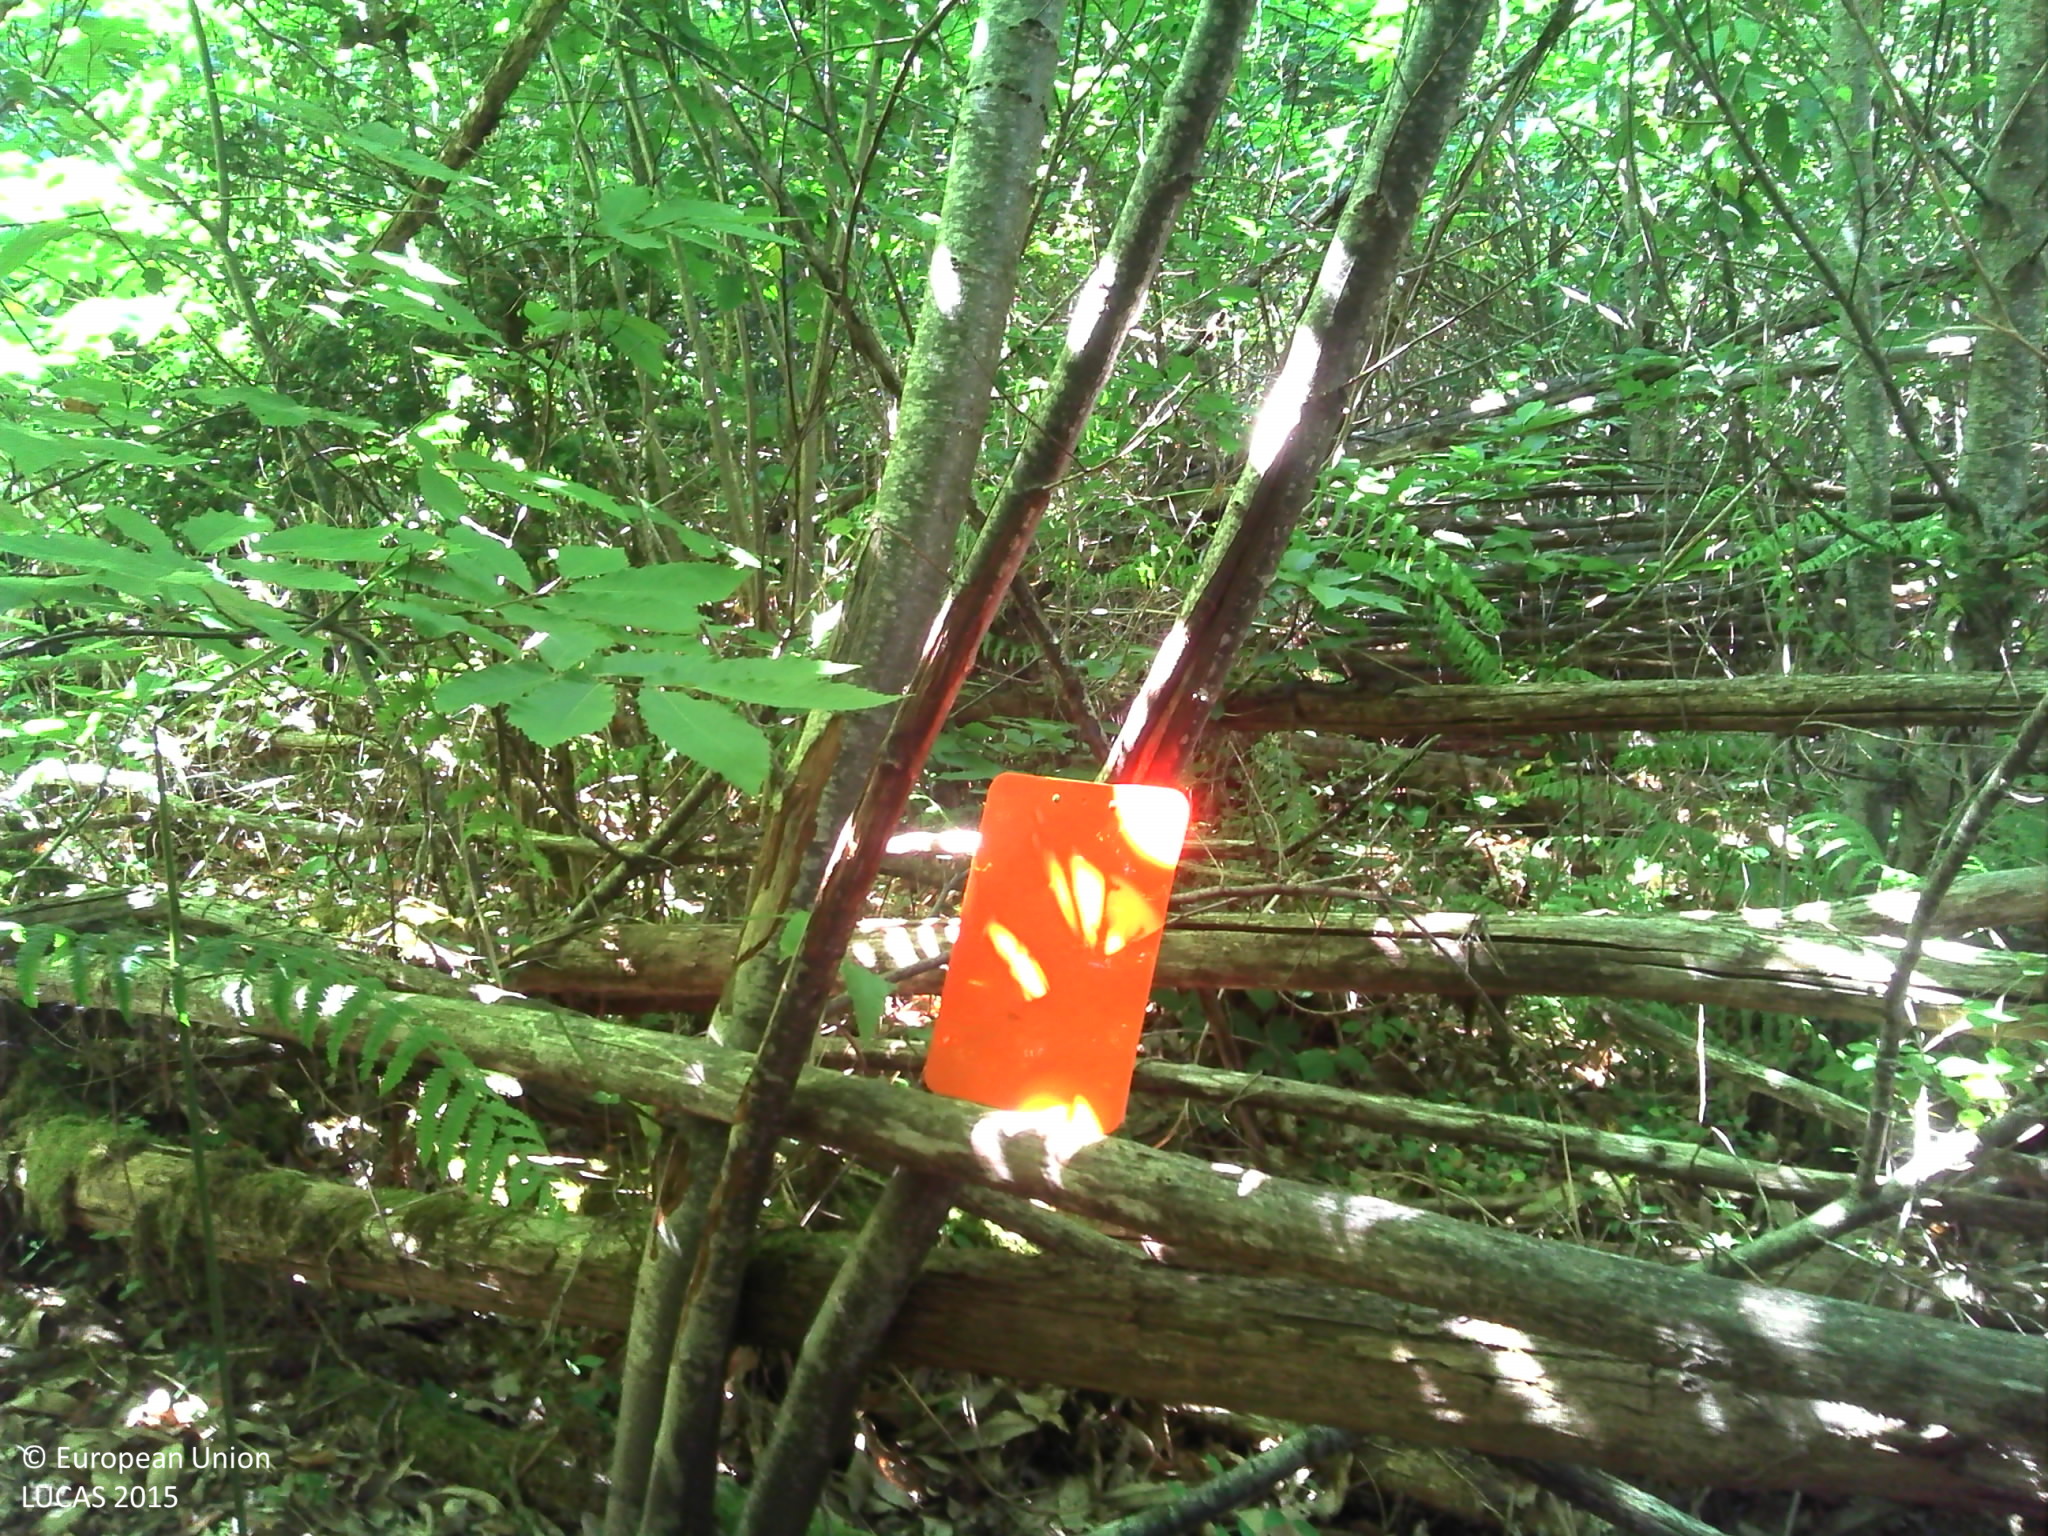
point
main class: Woodland
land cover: Broadleaved woodland
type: thermophilous deciduous forest
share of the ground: > 75 %
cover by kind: broadleaved forest trees 80 %, shrubs 15 %, herbaceous plants 5 %
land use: Semi-natural and natural areas not in use
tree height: > 5 m
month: June
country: FR
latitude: 45.7610
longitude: 0.6656
